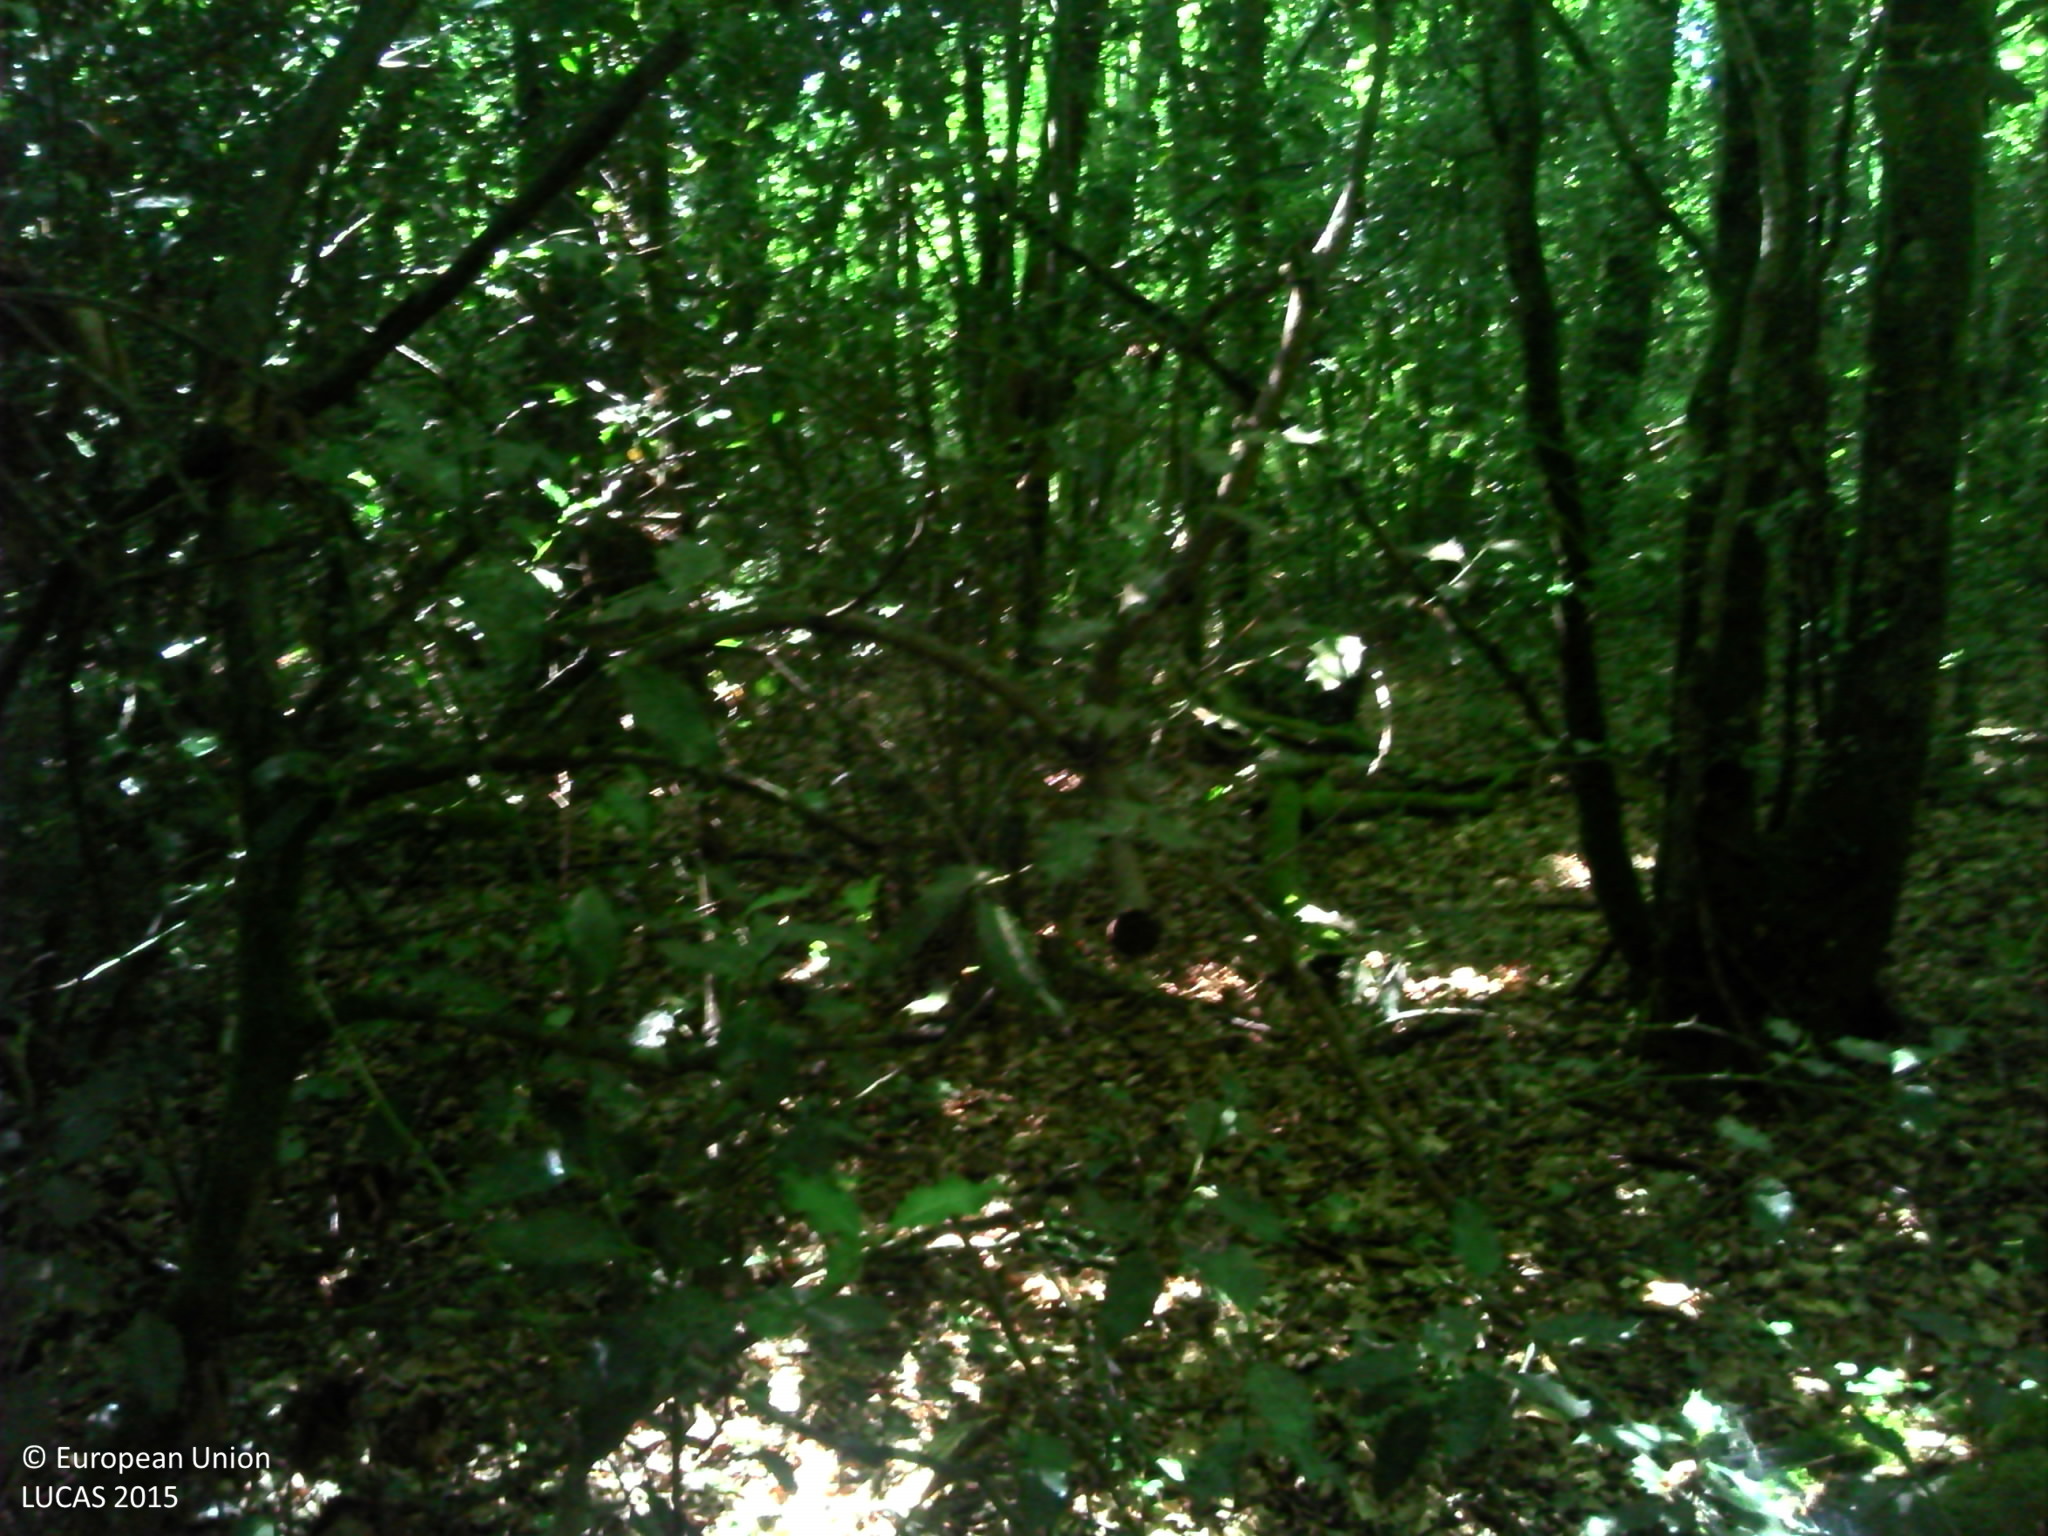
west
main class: Woodland
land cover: Broadleaved woodland
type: beech forest
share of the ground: > 75 %
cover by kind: broadleaved forest trees 100 %
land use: Forestry
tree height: > 5 m
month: July
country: FR
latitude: 46.1742
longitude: 1.7151
